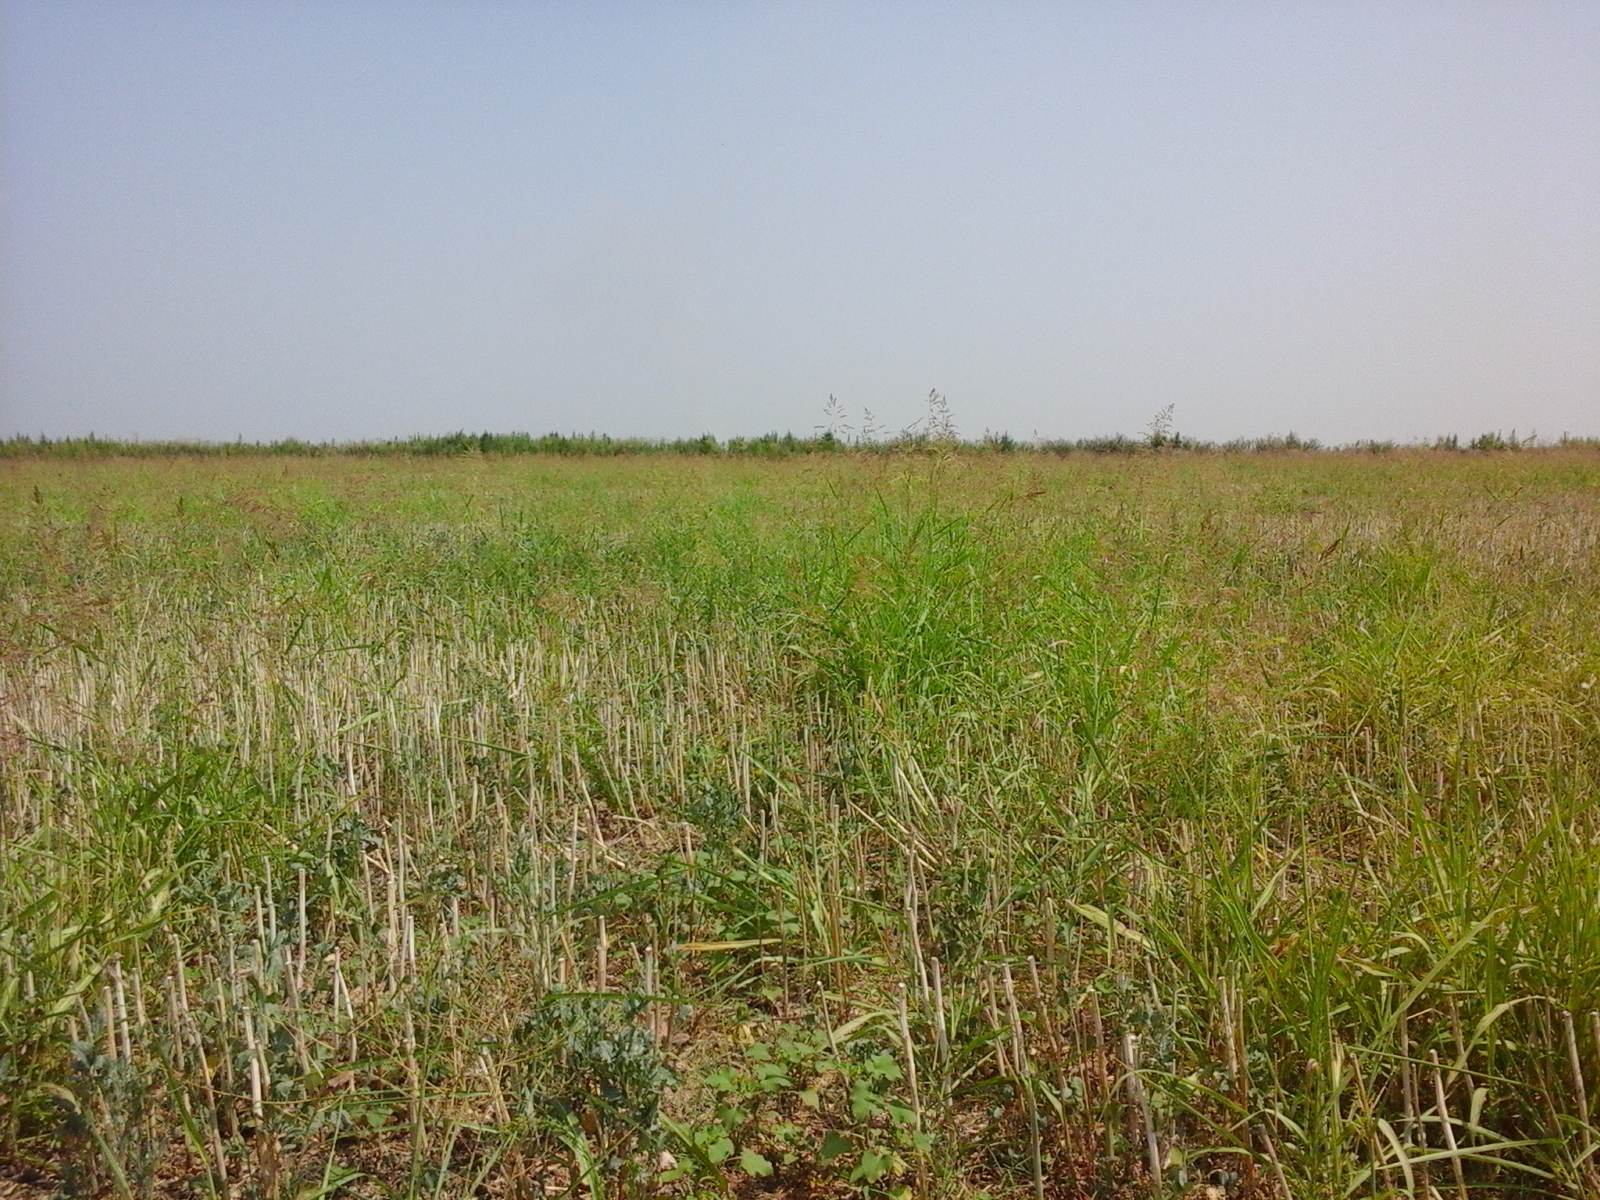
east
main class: Cropland
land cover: Rape and turnip rape
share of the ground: 10 - 25 %
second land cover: Spontaneously vegetated surfaces
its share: > 75 %
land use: Agriculture (excluding fallow land and kitchen gardens)
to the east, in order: Rape and turnip rape; Spontaneously vegetated surfaces; Ditches and canals; Spontaneously vegetated surfaces; Common wheat
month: August
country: RO
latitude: 43.9415
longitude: 23.3394
